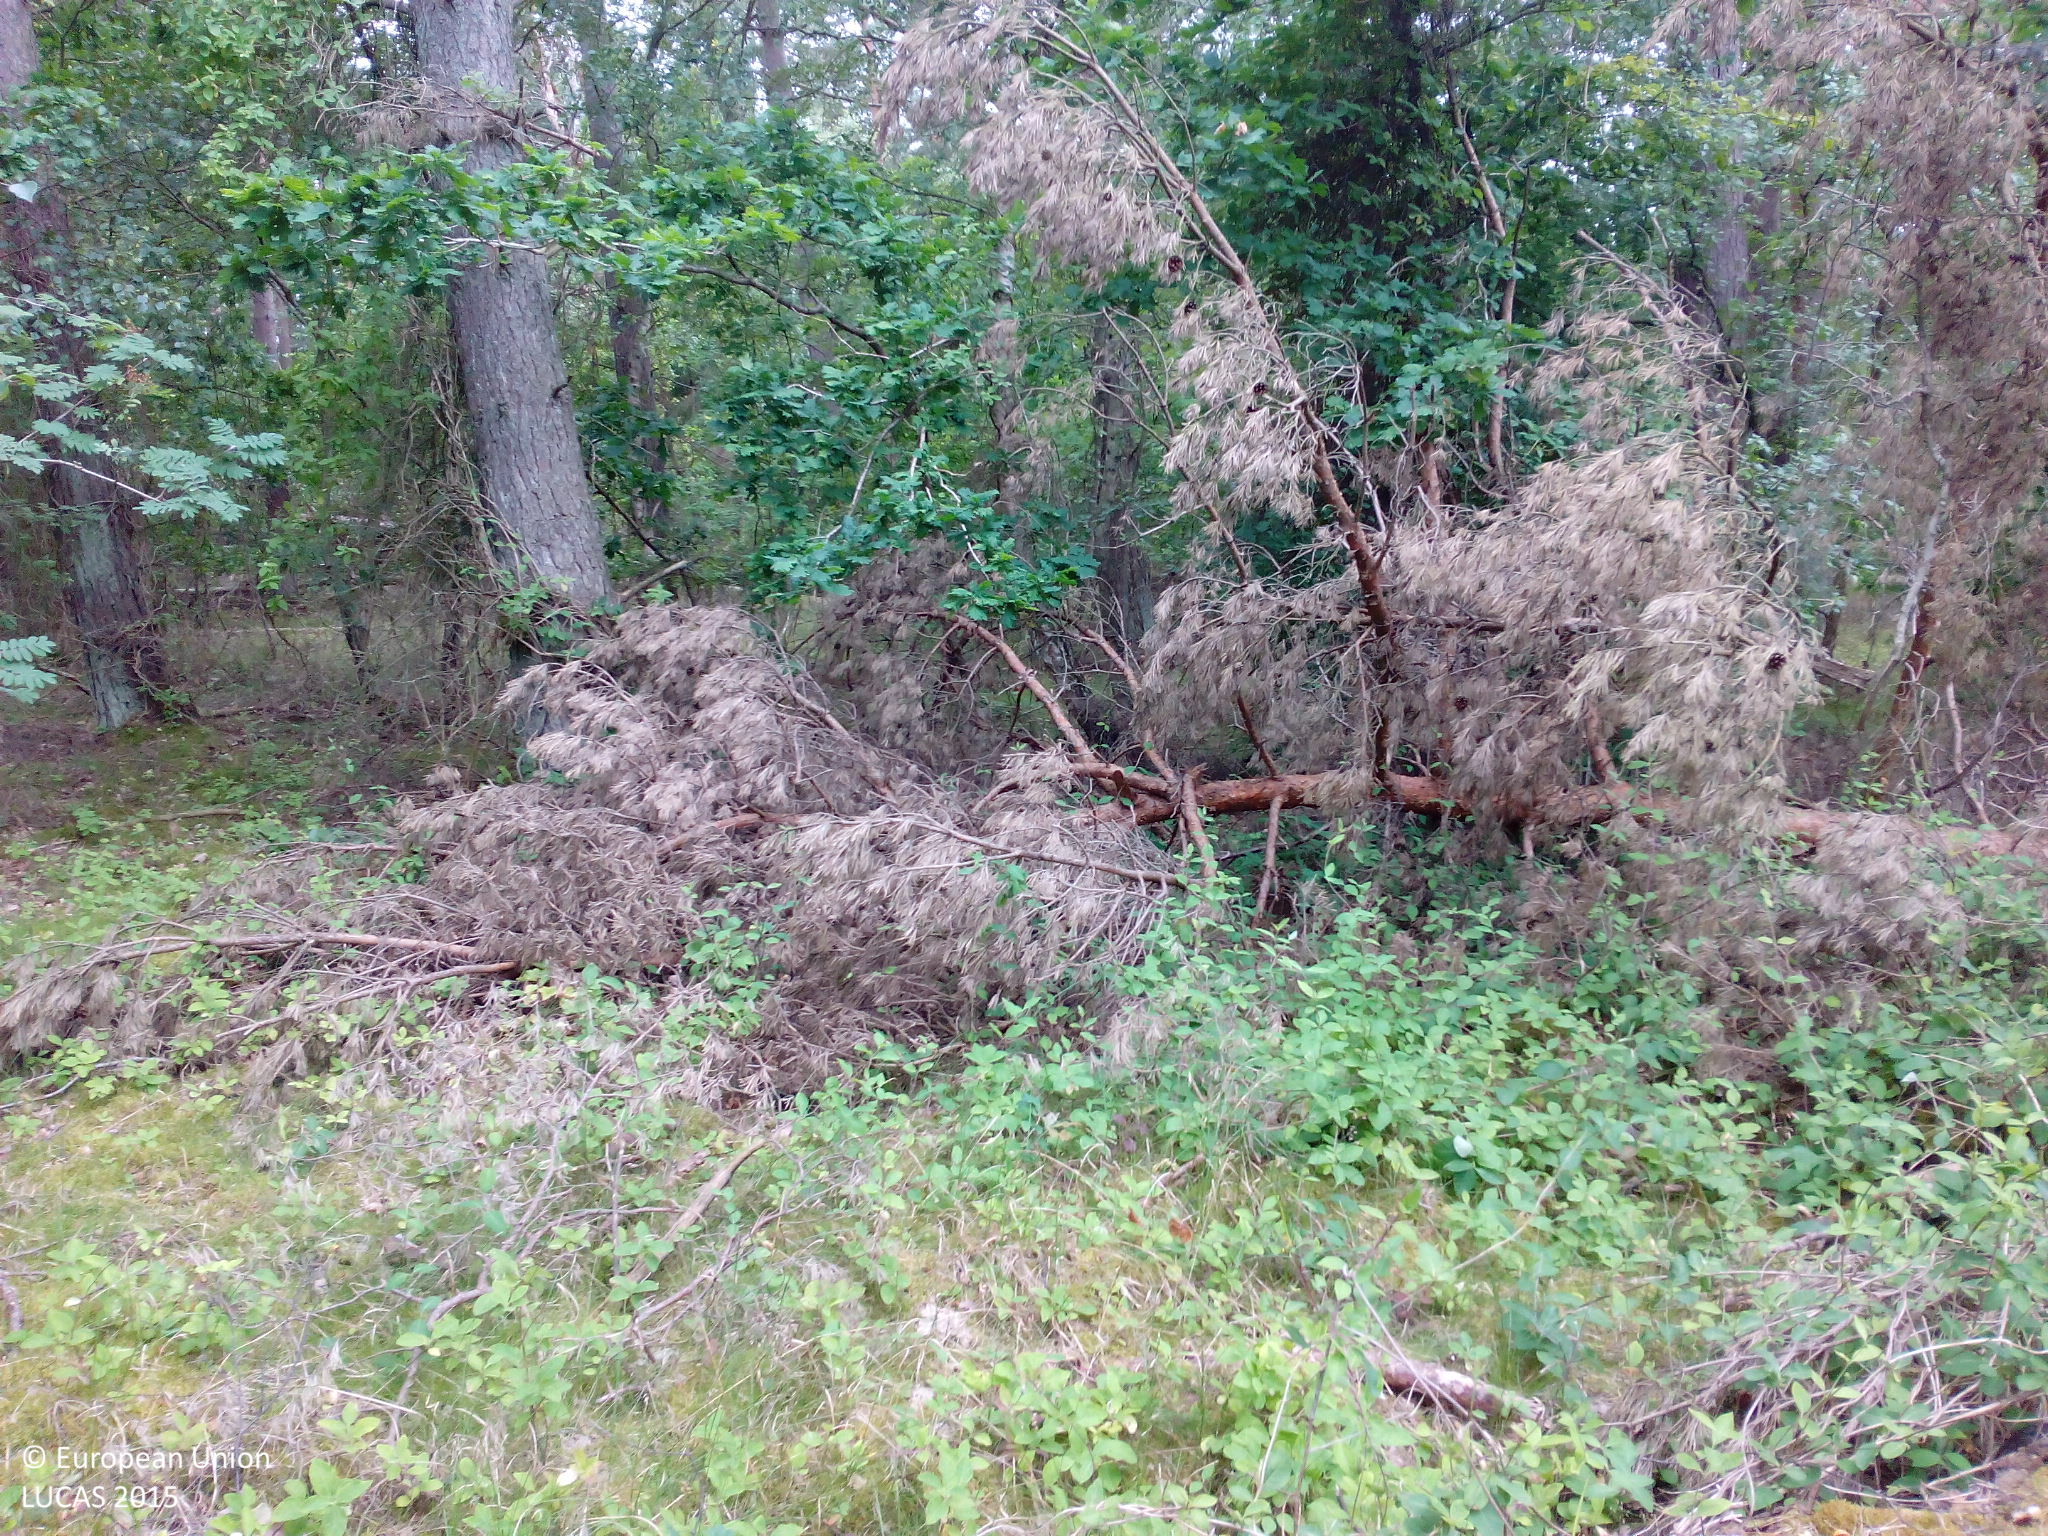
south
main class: Woodland
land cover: Pine dominated mixed woodland
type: hemiboreal forest and nemoral coniferous forest and mixed broadleaved-coniferous forest
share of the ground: > 75 %
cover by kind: coniferous forest trees 75 %, broadleaved forest trees 25 %
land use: Residential
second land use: Amenities, museums, leisure
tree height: > 5 m
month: July
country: DK
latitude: 56.0103
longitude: 12.0029
